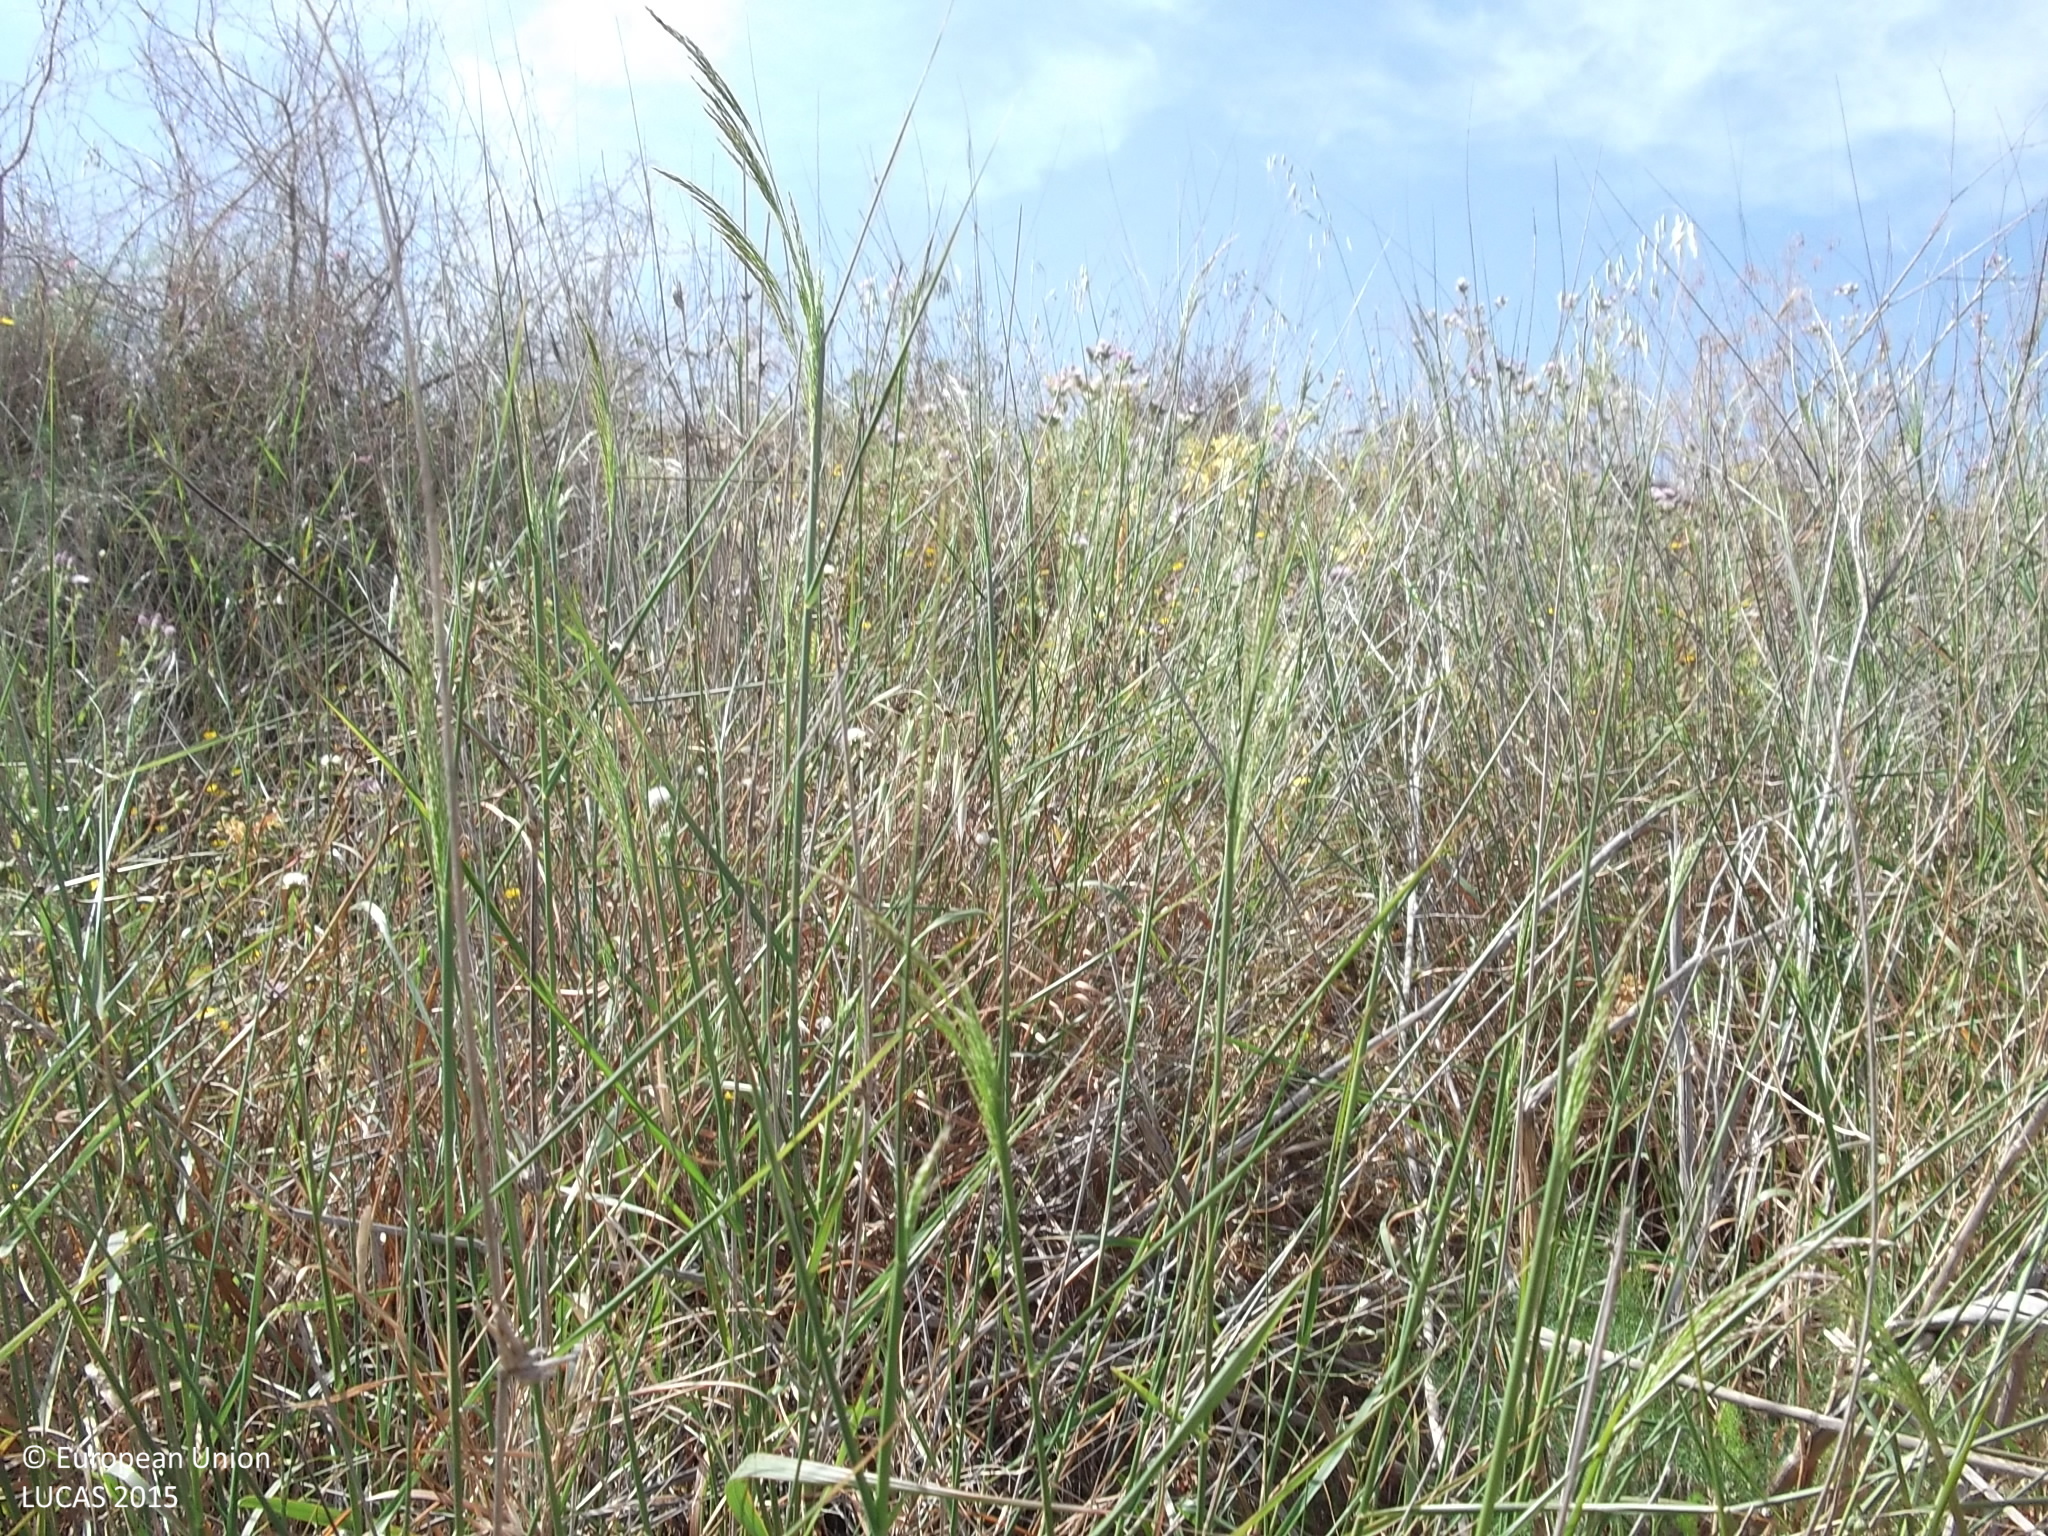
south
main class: Shrubland
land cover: Shrubland without tree cover
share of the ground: > 75 %
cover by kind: shrubs 85 %, herbaceous plants 15 %
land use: Abandoned areas
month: April
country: ES
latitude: 38.0243
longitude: -0.9766
